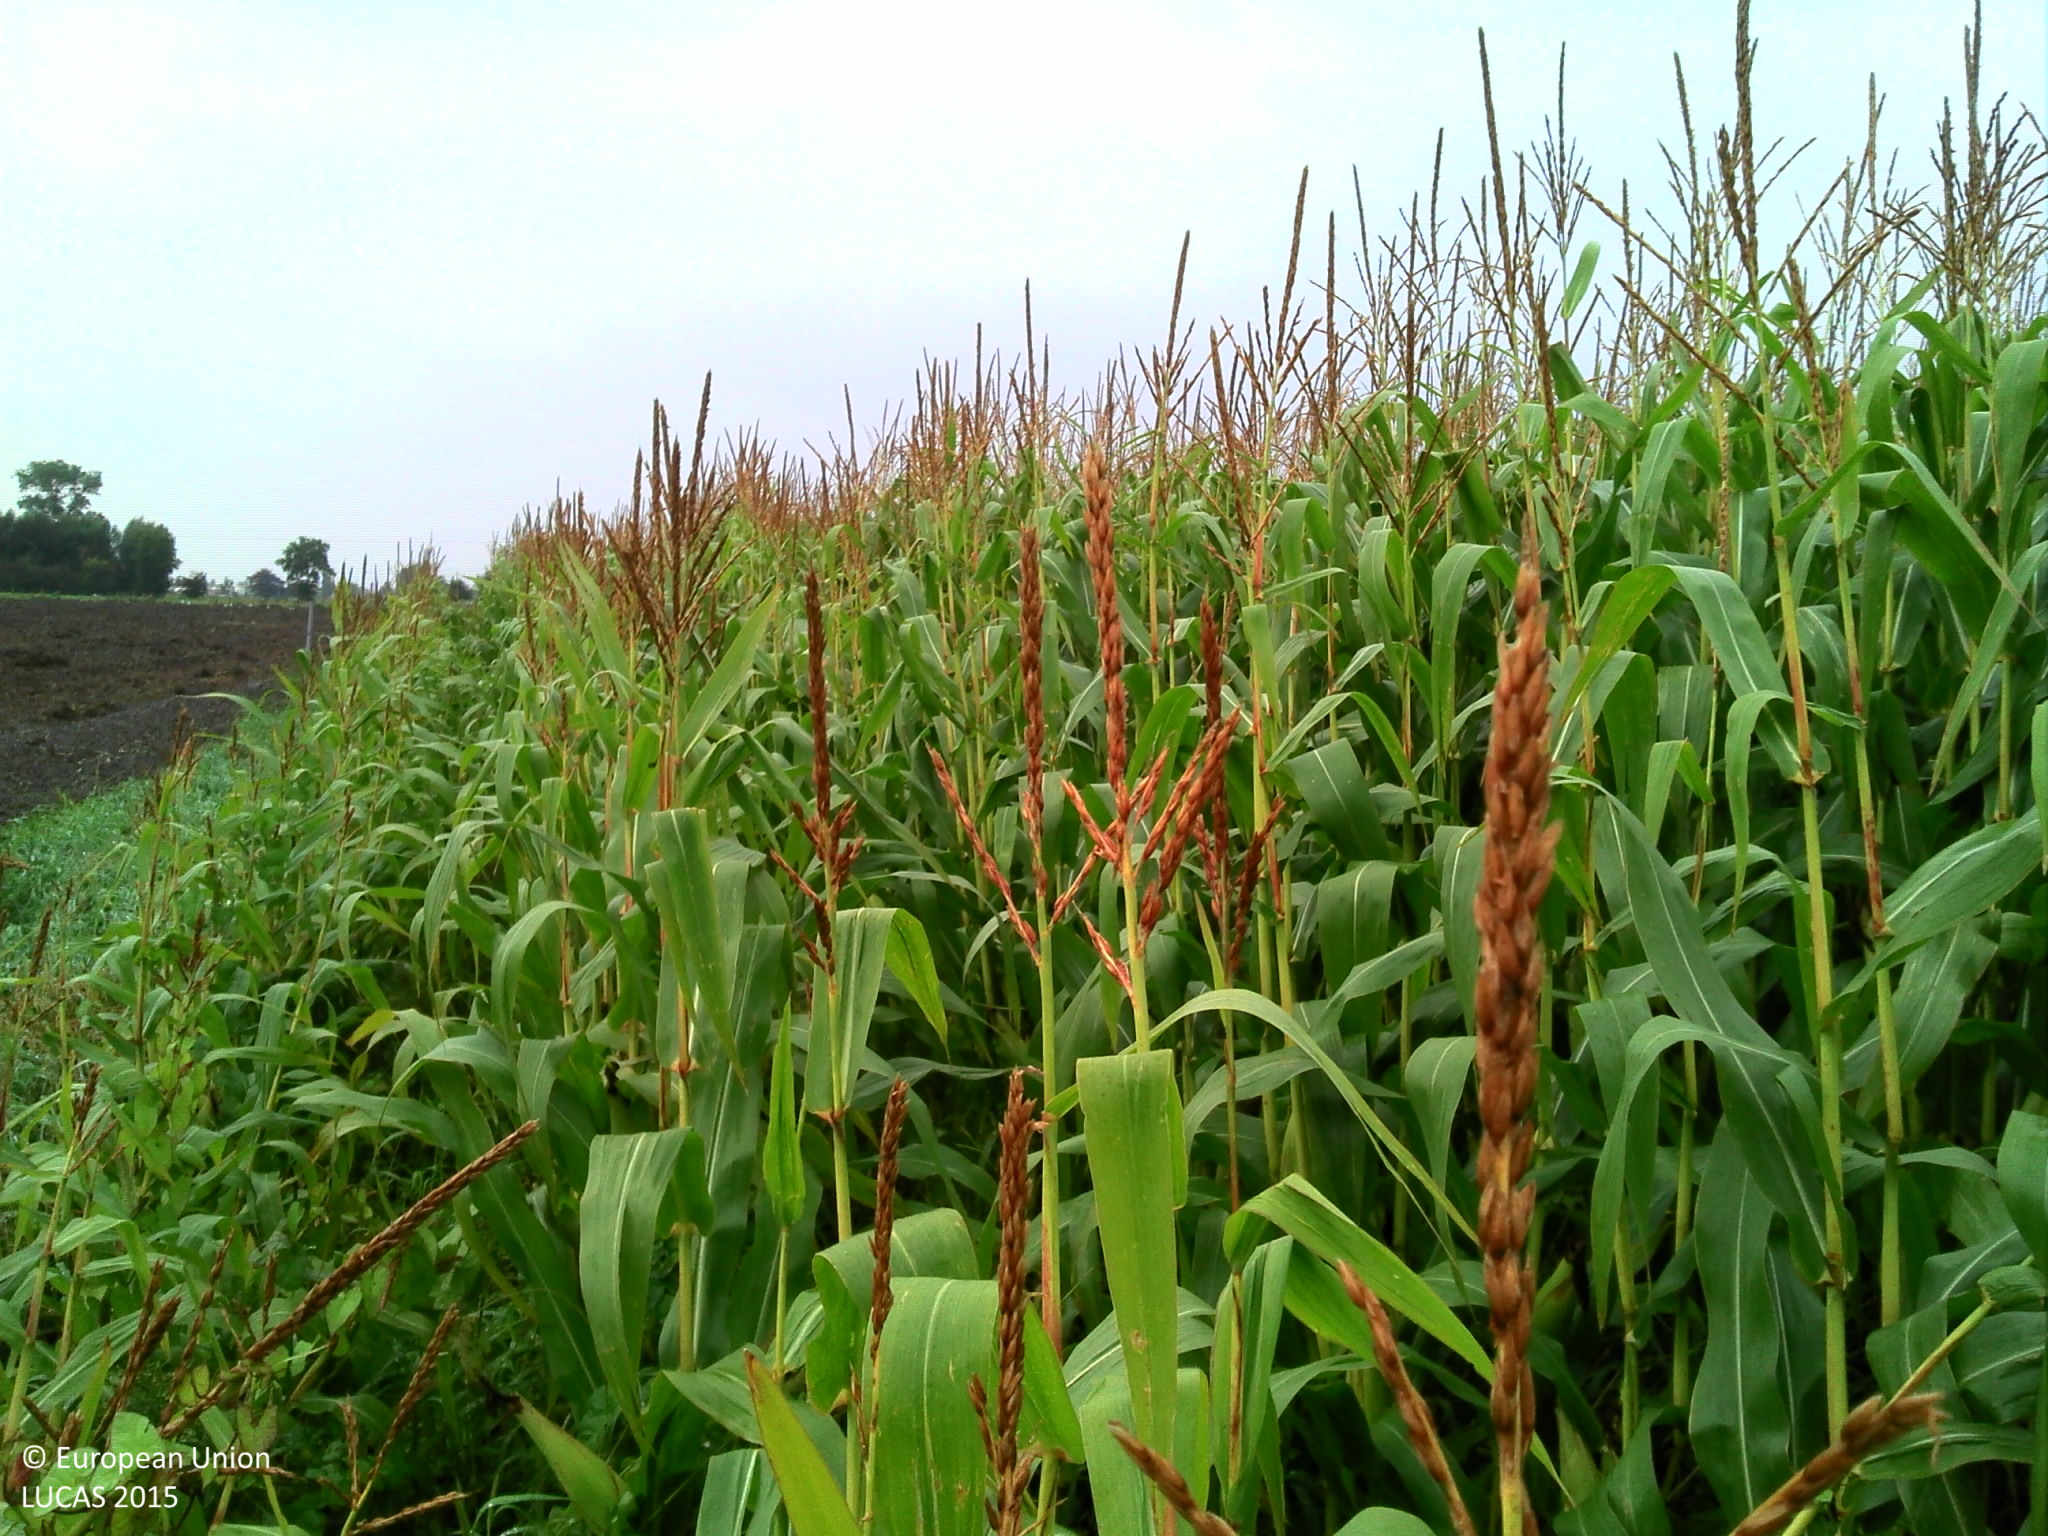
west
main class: Cropland
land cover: Maize
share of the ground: > 75 %
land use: Agriculture (excluding fallow land and kitchen gardens)
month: September
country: BE
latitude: 51.1635
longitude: 3.0546
